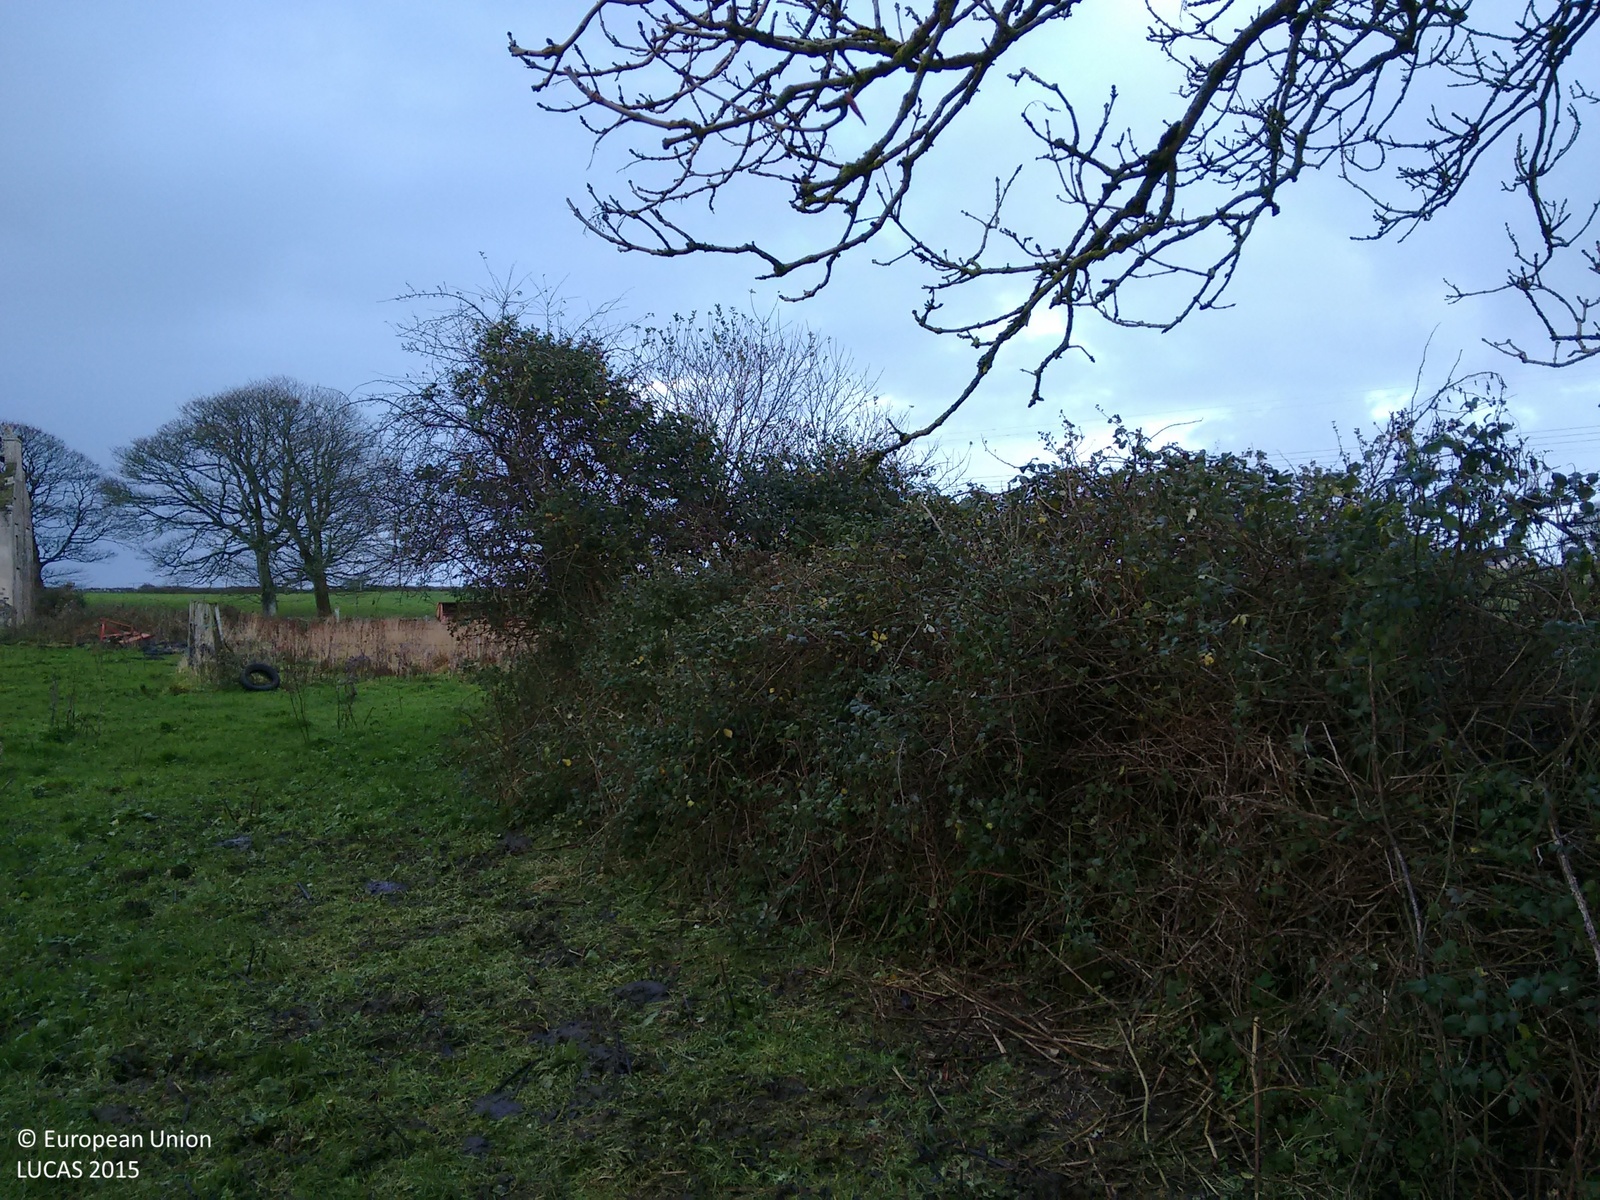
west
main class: Grassland
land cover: Grassland without tree/shrub cover
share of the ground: > 75 %
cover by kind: herbaceous plants 100 %
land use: Agriculture (excluding fallow land and kitchen gardens)
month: November
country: IE
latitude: 54.4816
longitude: -8.1919
